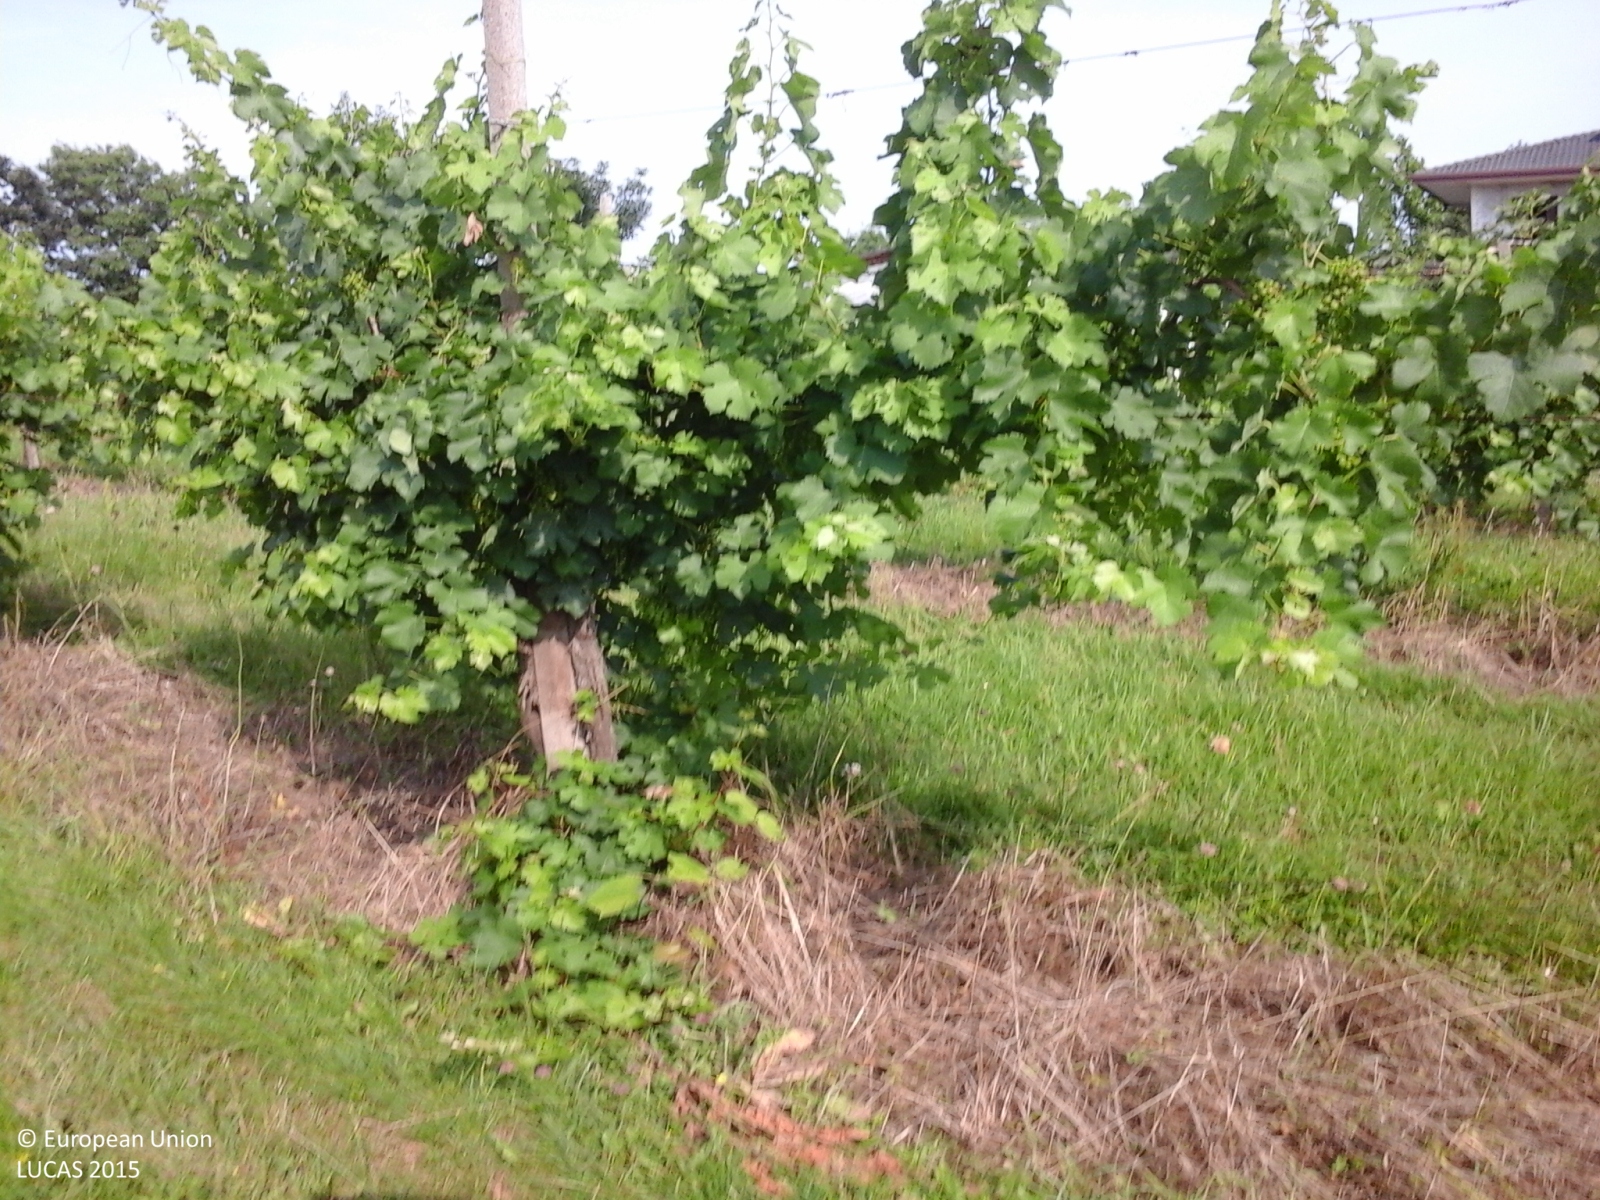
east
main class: Cropland
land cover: Vineyards
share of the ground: 10 - 25 %
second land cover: Grassland without tree/shrub cover
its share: > 75 %
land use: Agriculture (excluding fallow land and kitchen gardens)
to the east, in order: Vineyards; Grassland without tree/shrub cover; Ditches and canals; Grassland without tree/shrub cover; Ditches and canals; Lines of trees; Grassland without tree/shrub cover; Ditches and canals; Abandoned hedges; Grassland without tree/shrub cover; Ditches and canals; Spontaneously vegetated surfaces; Ditches and canals; Soya; Ditches and canals; Soya
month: June
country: IT
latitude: 45.7762
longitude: 12.7099
